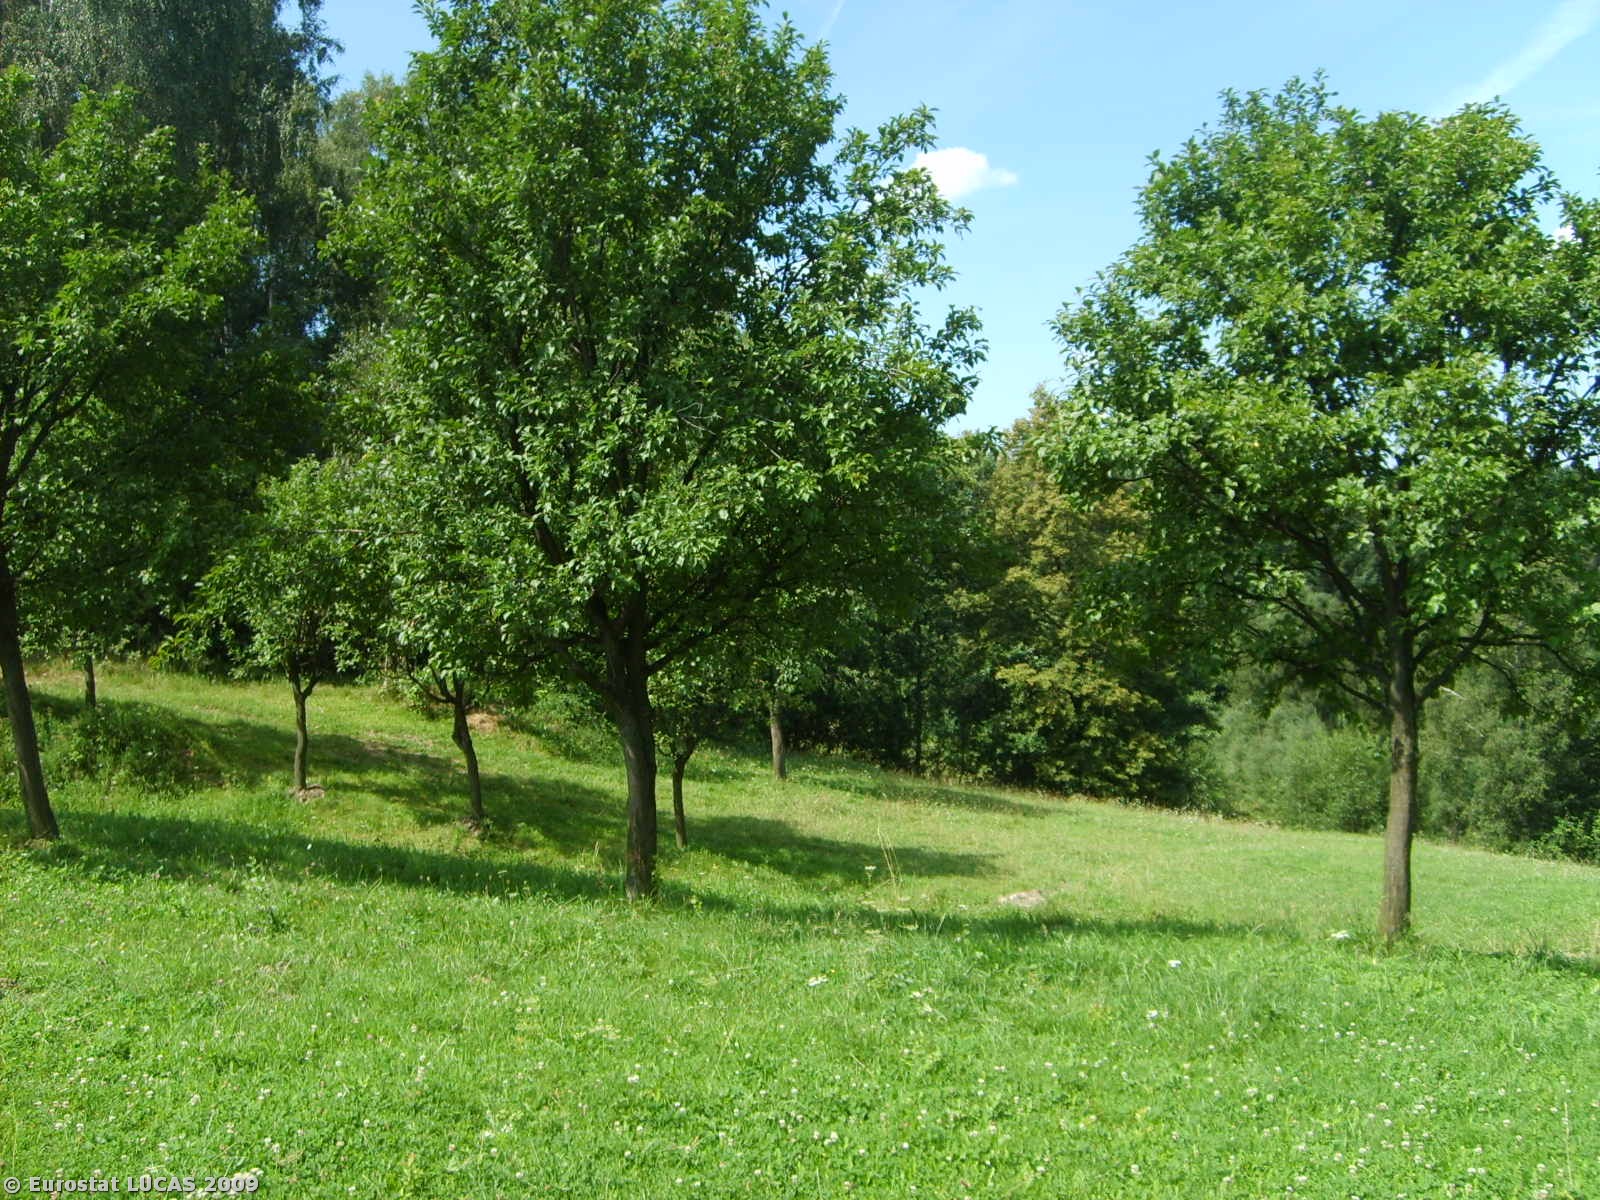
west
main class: Grassland
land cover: Grassland without tree/shrub cover
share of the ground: > 75 %
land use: Agriculture (excluding fallow land and kitchen gardens)
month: July
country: PL
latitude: 49.8627
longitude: 20.4847
